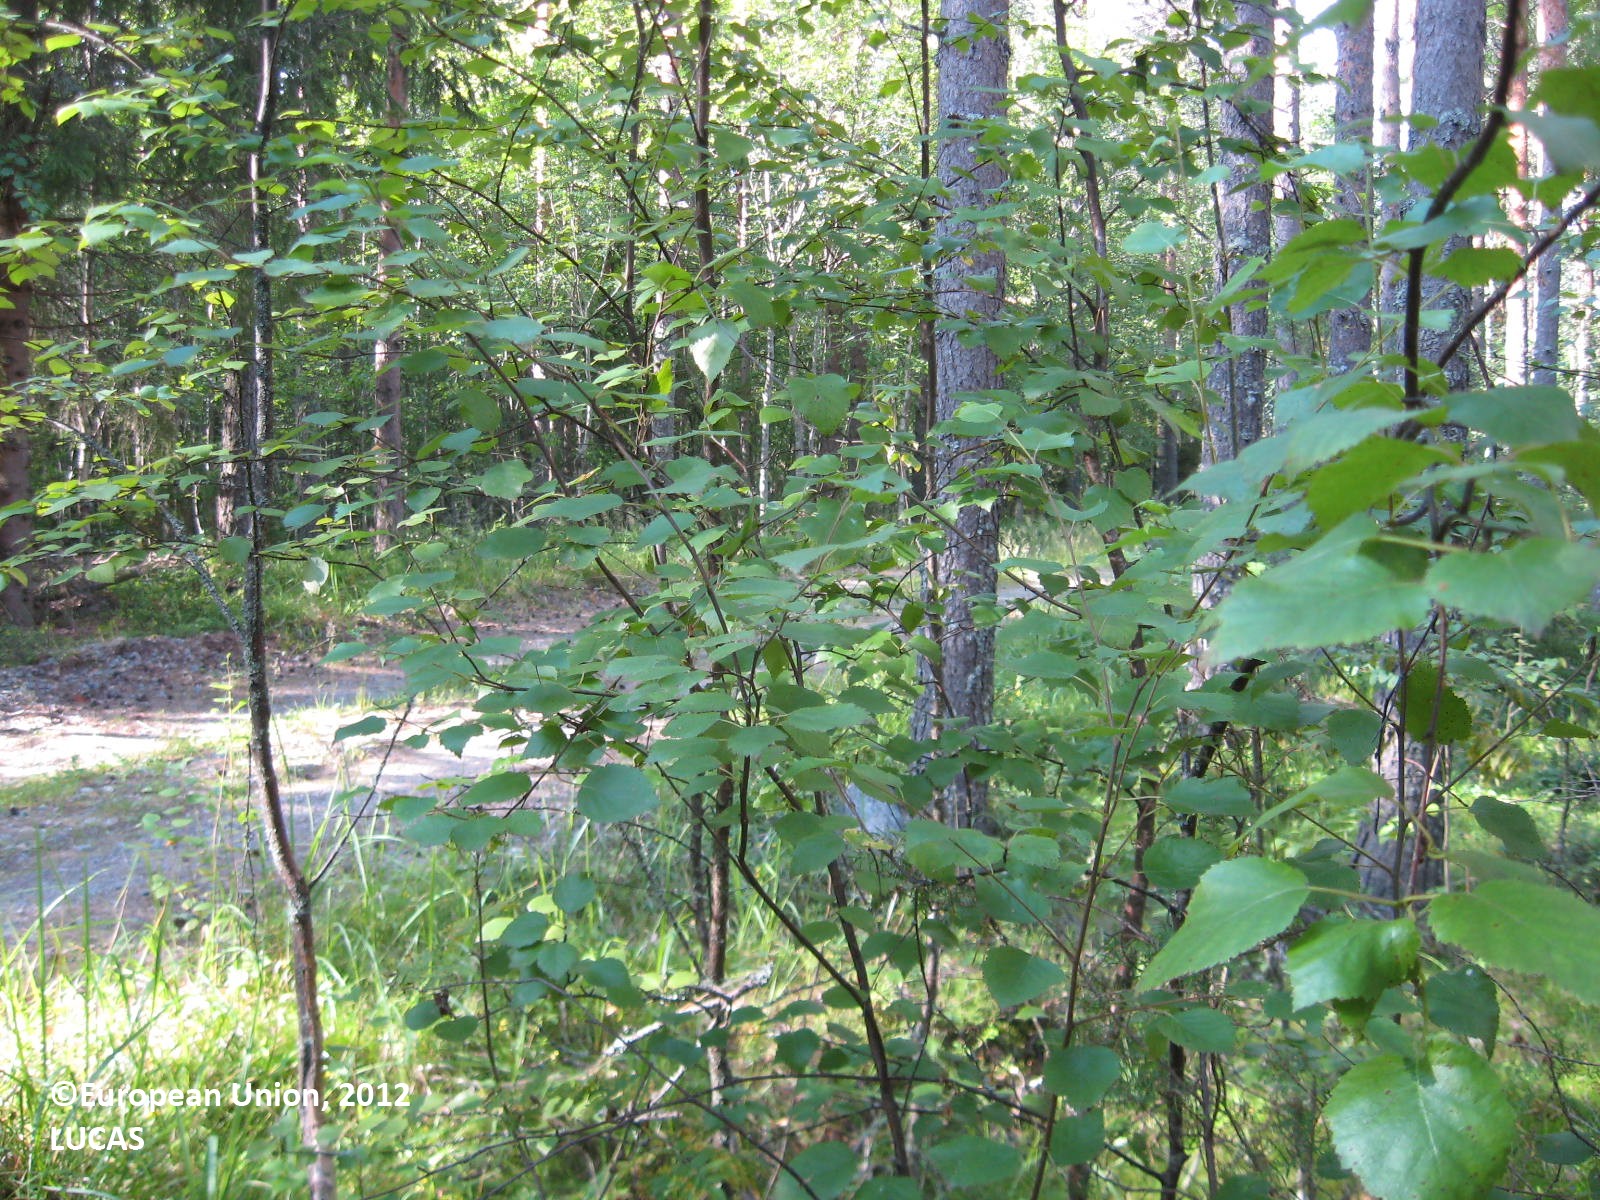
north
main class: Woodland
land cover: Pine dominated mixed woodland
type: boreal forest
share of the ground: > 75 %
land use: Forestry
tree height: > 5 m
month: July
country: FI
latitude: 61.9504
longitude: 22.6242
